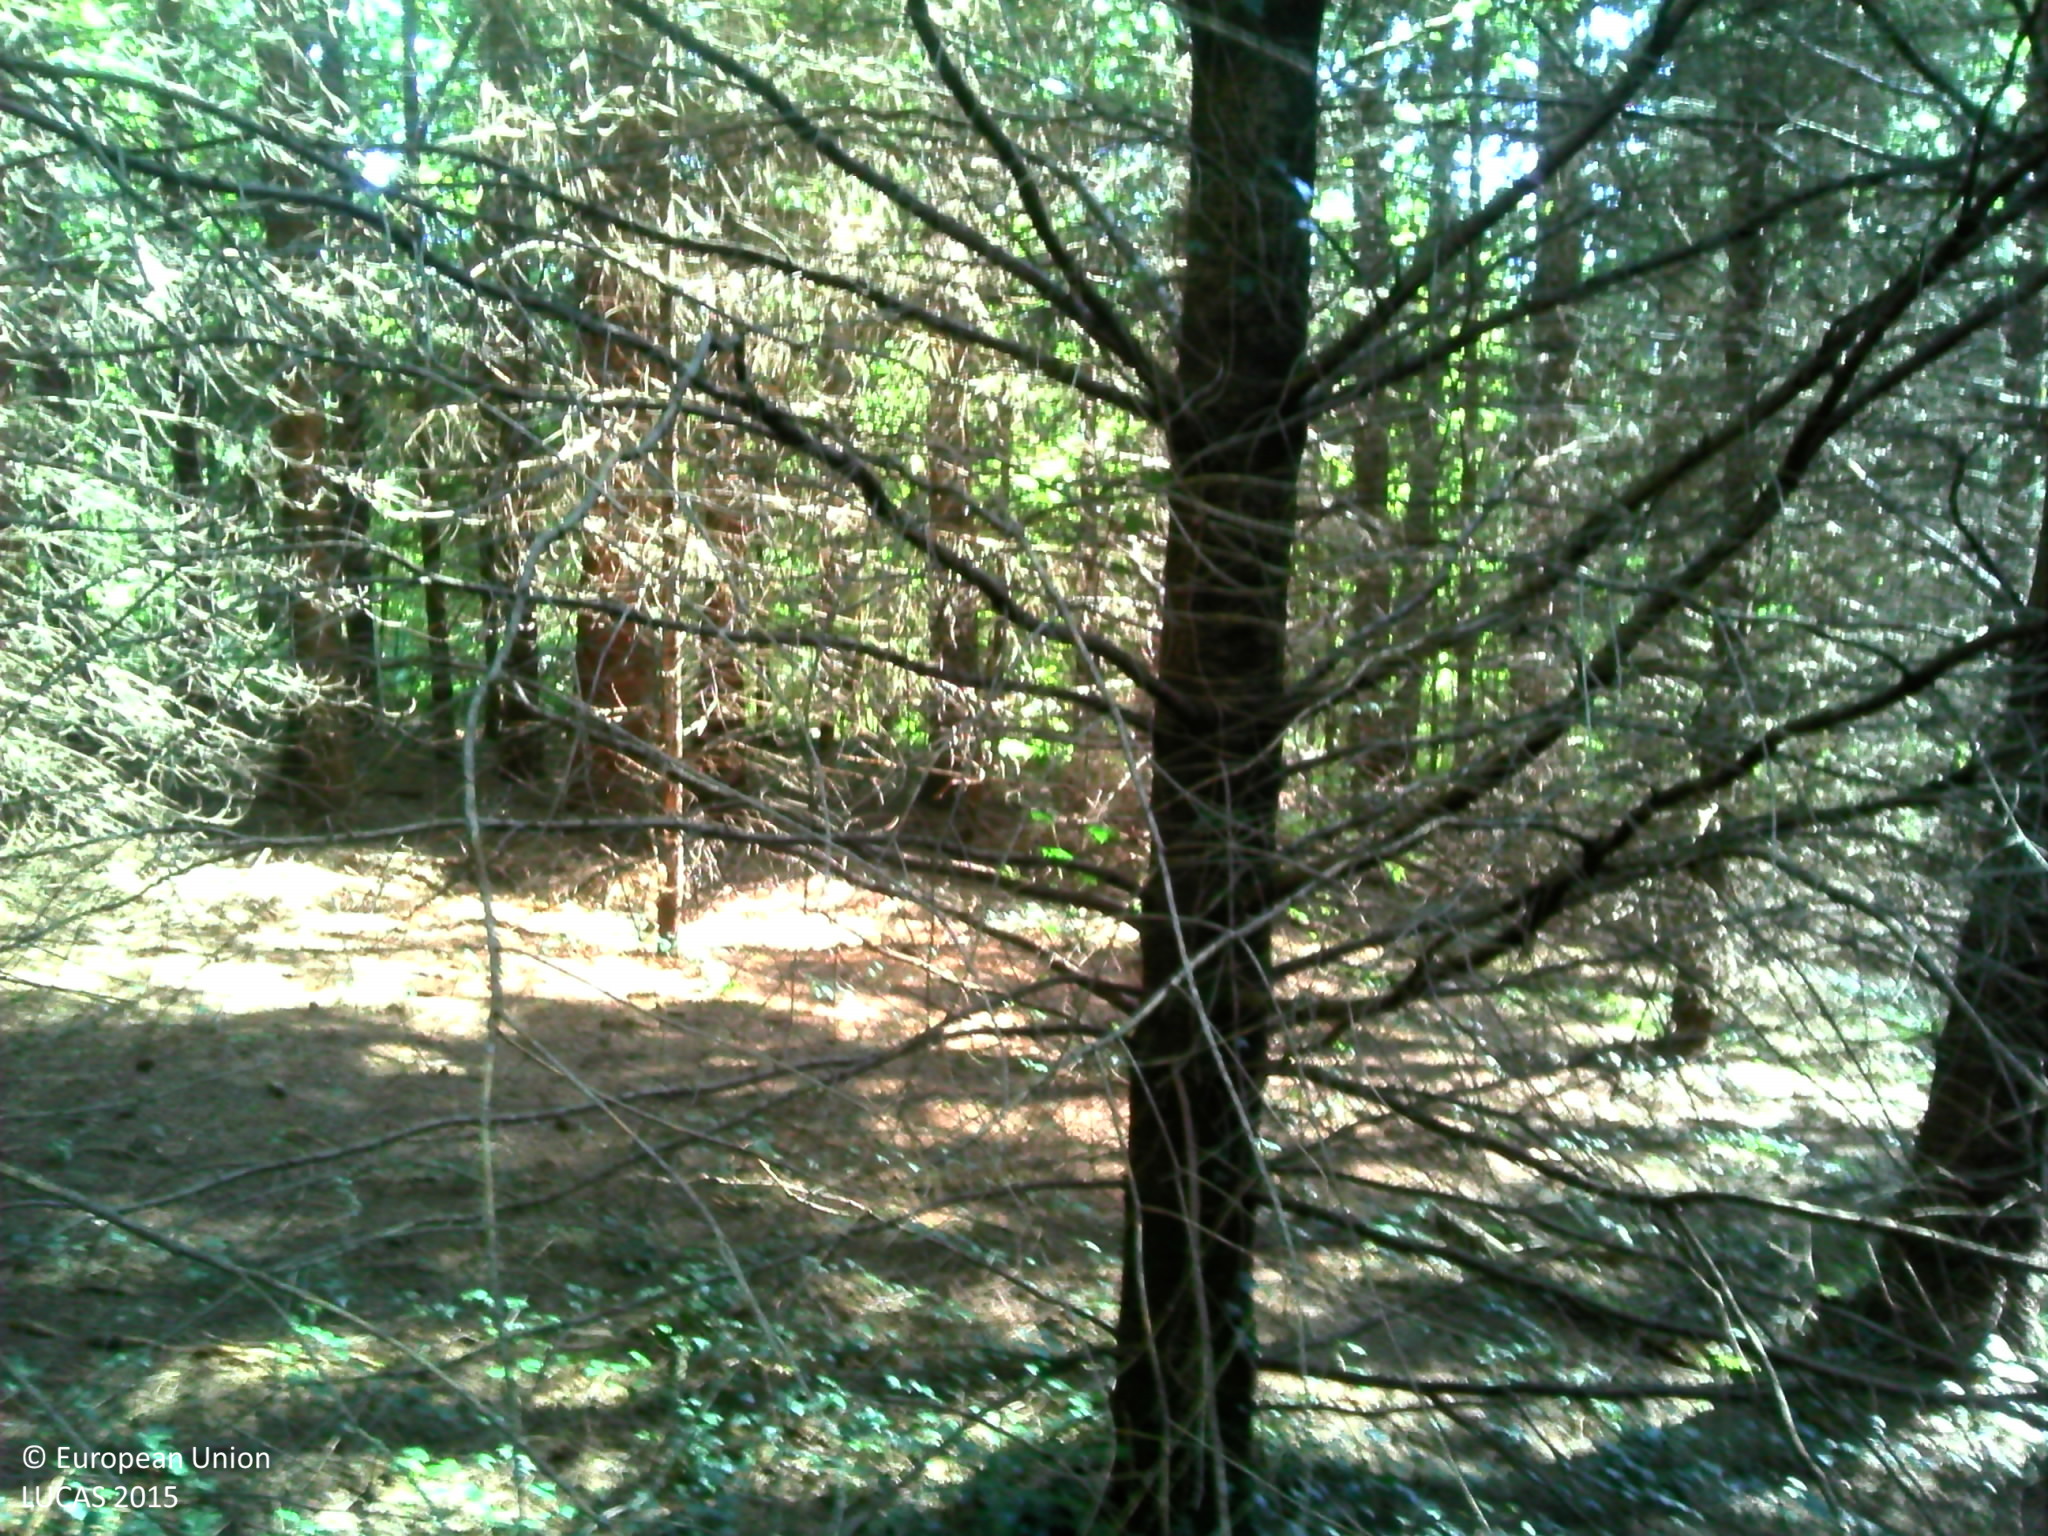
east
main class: Woodland
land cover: Spruce dominated coniferous woodland
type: hemiboreal forest and nemoral coniferous forest and mixed broadleaved-coniferous forest
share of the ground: > 75 %
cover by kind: coniferous forest trees 75 %, herbaceous plants 25 %
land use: Forestry
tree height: > 5 m
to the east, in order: Spruce dominated coniferous woodland; Grass margins; Tracks; Spruce dominated coniferous woodland; Spruce dominated mixed woodland; Tracks; Broadleaved woodland; Spruce dominated mixed woodland
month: September
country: FR
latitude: 47.2054
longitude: 6.2658
